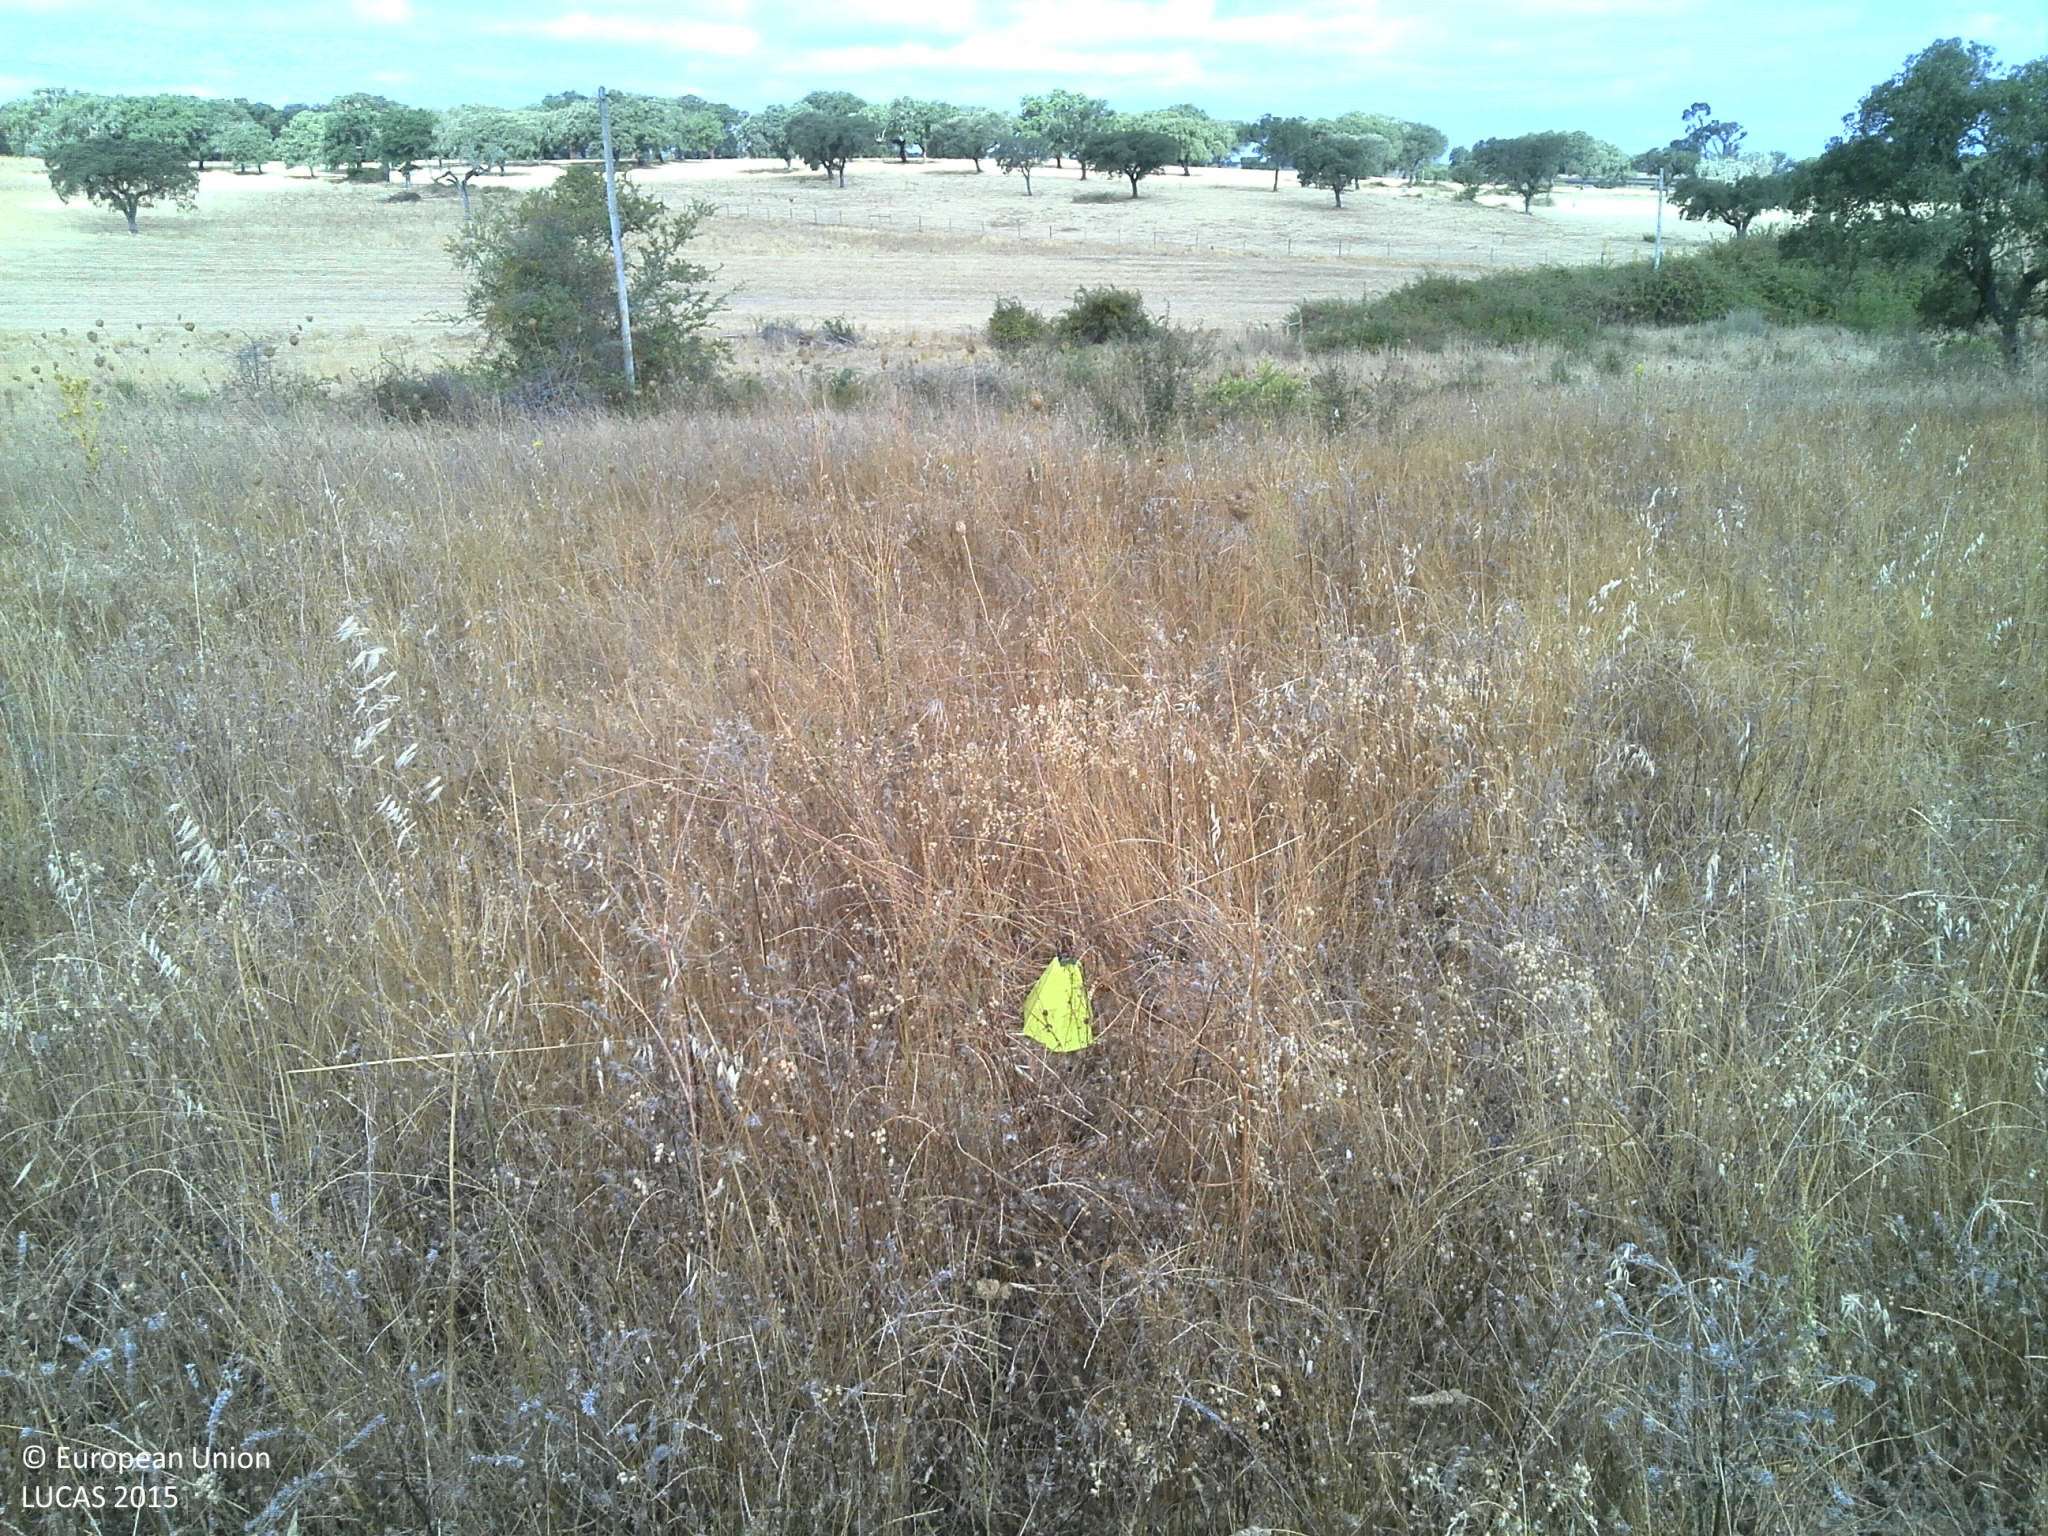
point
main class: Grassland
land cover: Grassland with sparse tree/shrub cover
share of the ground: > 75 %
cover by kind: herbaceous plants 70 %, unconsolidated bare surface 20 %, broadleaved forest trees 5 %, shrubs 5 %
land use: Agriculture (excluding fallow land and kitchen gardens)
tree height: < 5 m
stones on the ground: < 10 %
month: July
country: PT
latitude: 39.2033
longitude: -7.4685
